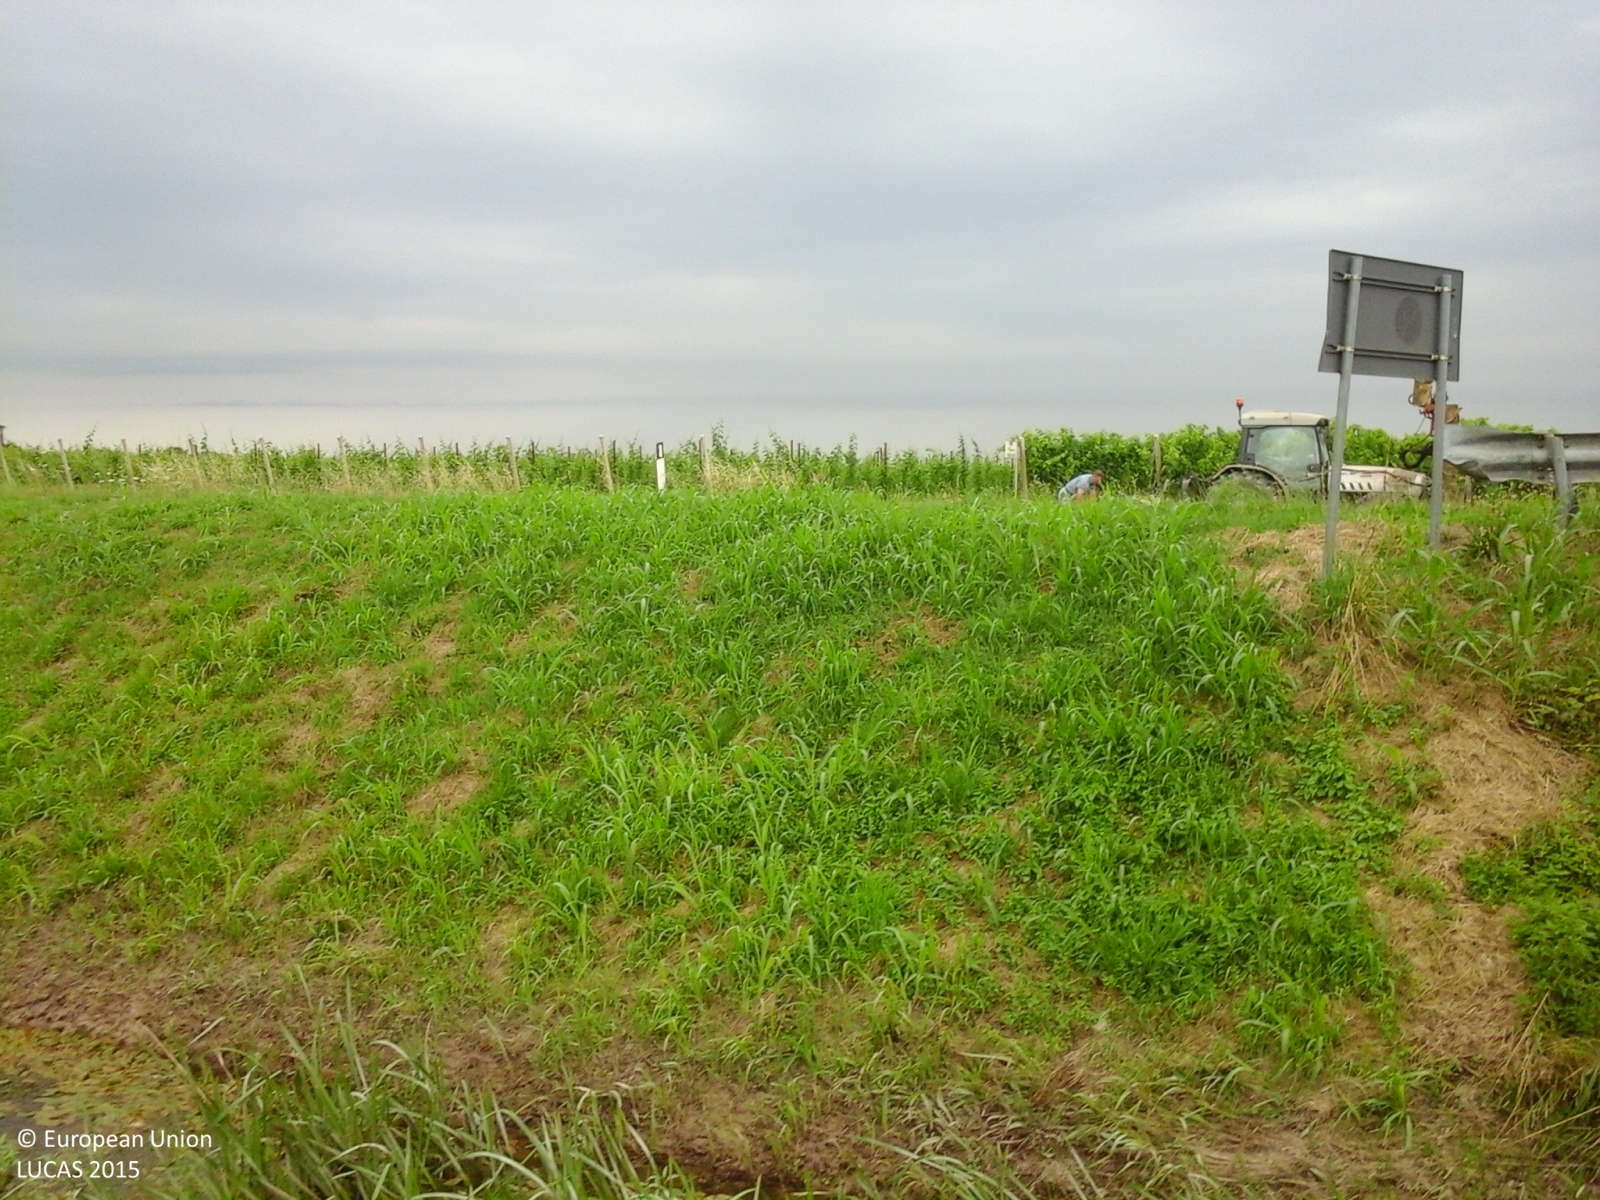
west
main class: Cropland
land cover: Maize
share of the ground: > 75 %
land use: Agriculture (excluding fallow land and kitchen gardens)
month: June
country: IT
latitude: 45.7234
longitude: 12.6560
